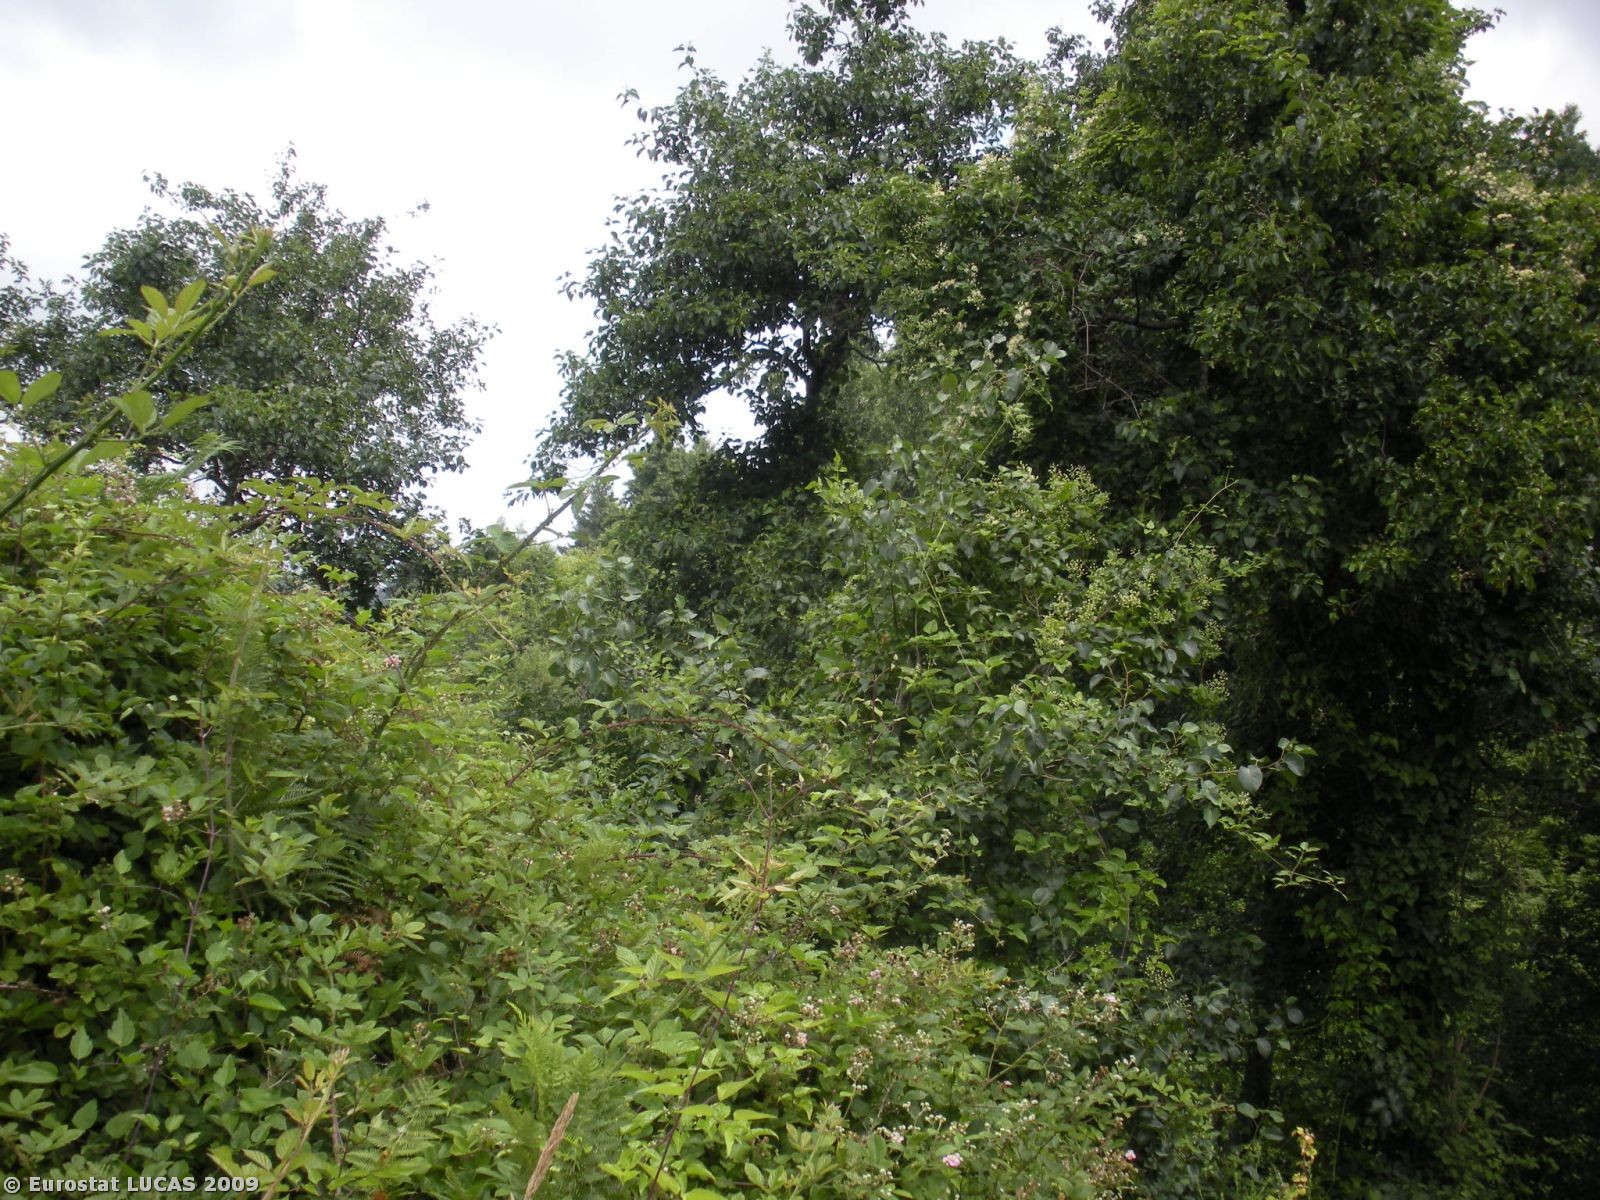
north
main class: Woodland
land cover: Broadleaved woodland
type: thermophilous deciduous forest
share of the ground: > 75 %
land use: Nature reserves
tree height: > 5 m
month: July
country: IT
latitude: 40.2644
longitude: 15.0456
